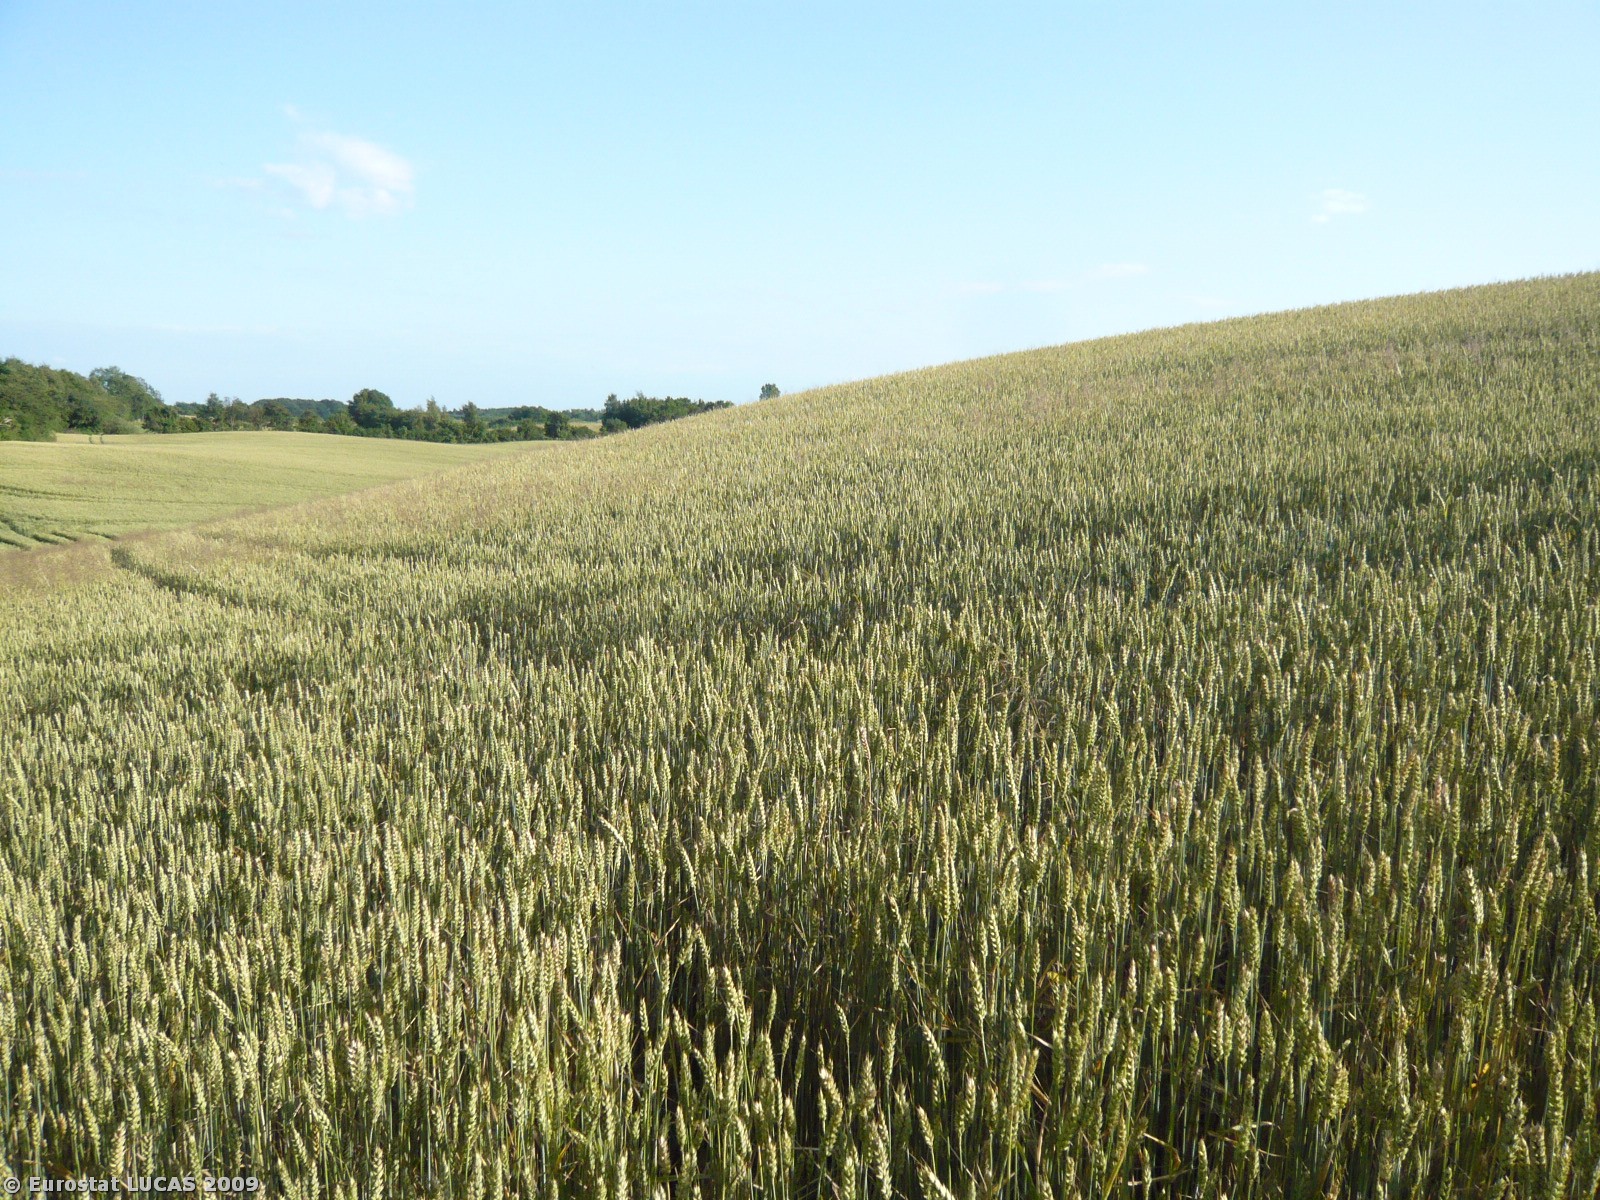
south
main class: Cropland
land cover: Common wheat
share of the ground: > 75 %
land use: Agriculture (excluding fallow land and kitchen gardens)
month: July
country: DK
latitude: 55.6043
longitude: 11.4431
